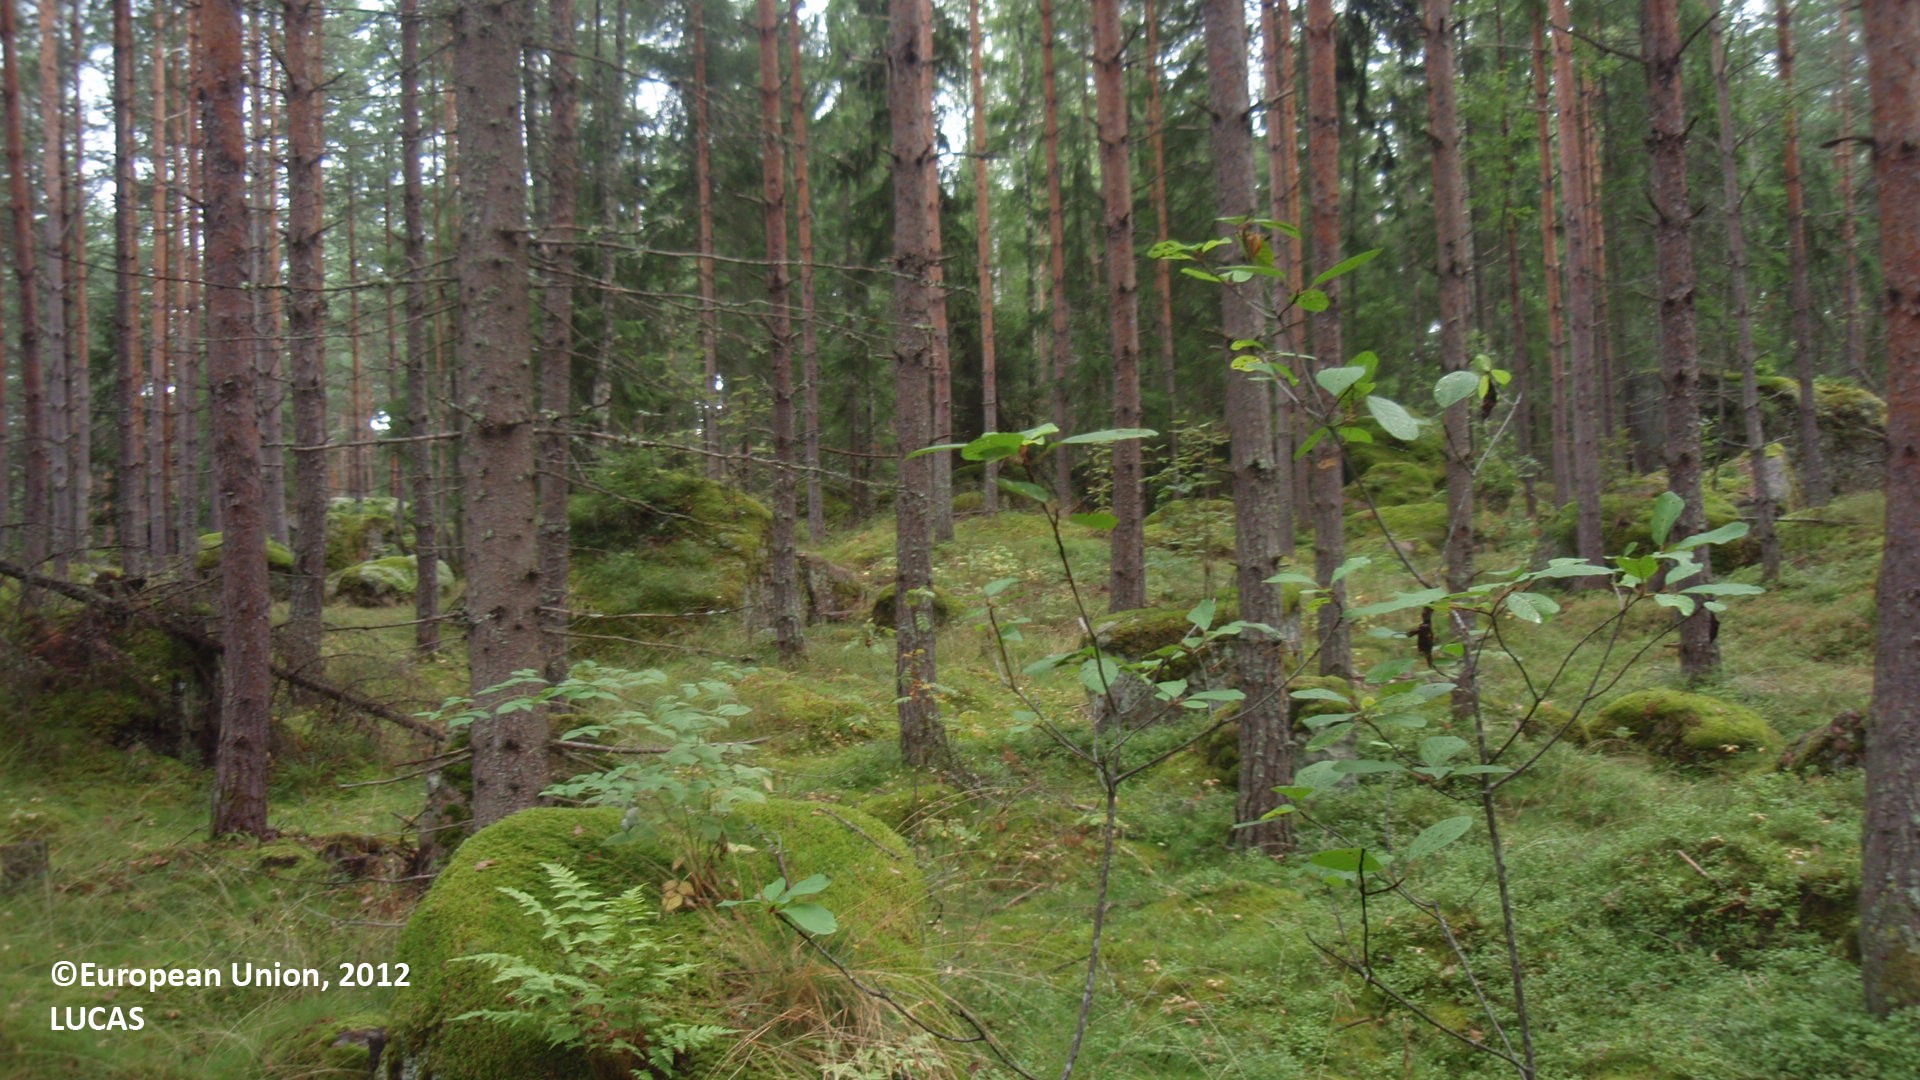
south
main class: Woodland
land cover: Pine dominated mixed woodland
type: boreal forest
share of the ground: 50 - 75 %
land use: Forestry
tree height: > 5 m
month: August
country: FI
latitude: 60.6020
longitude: 26.6510
